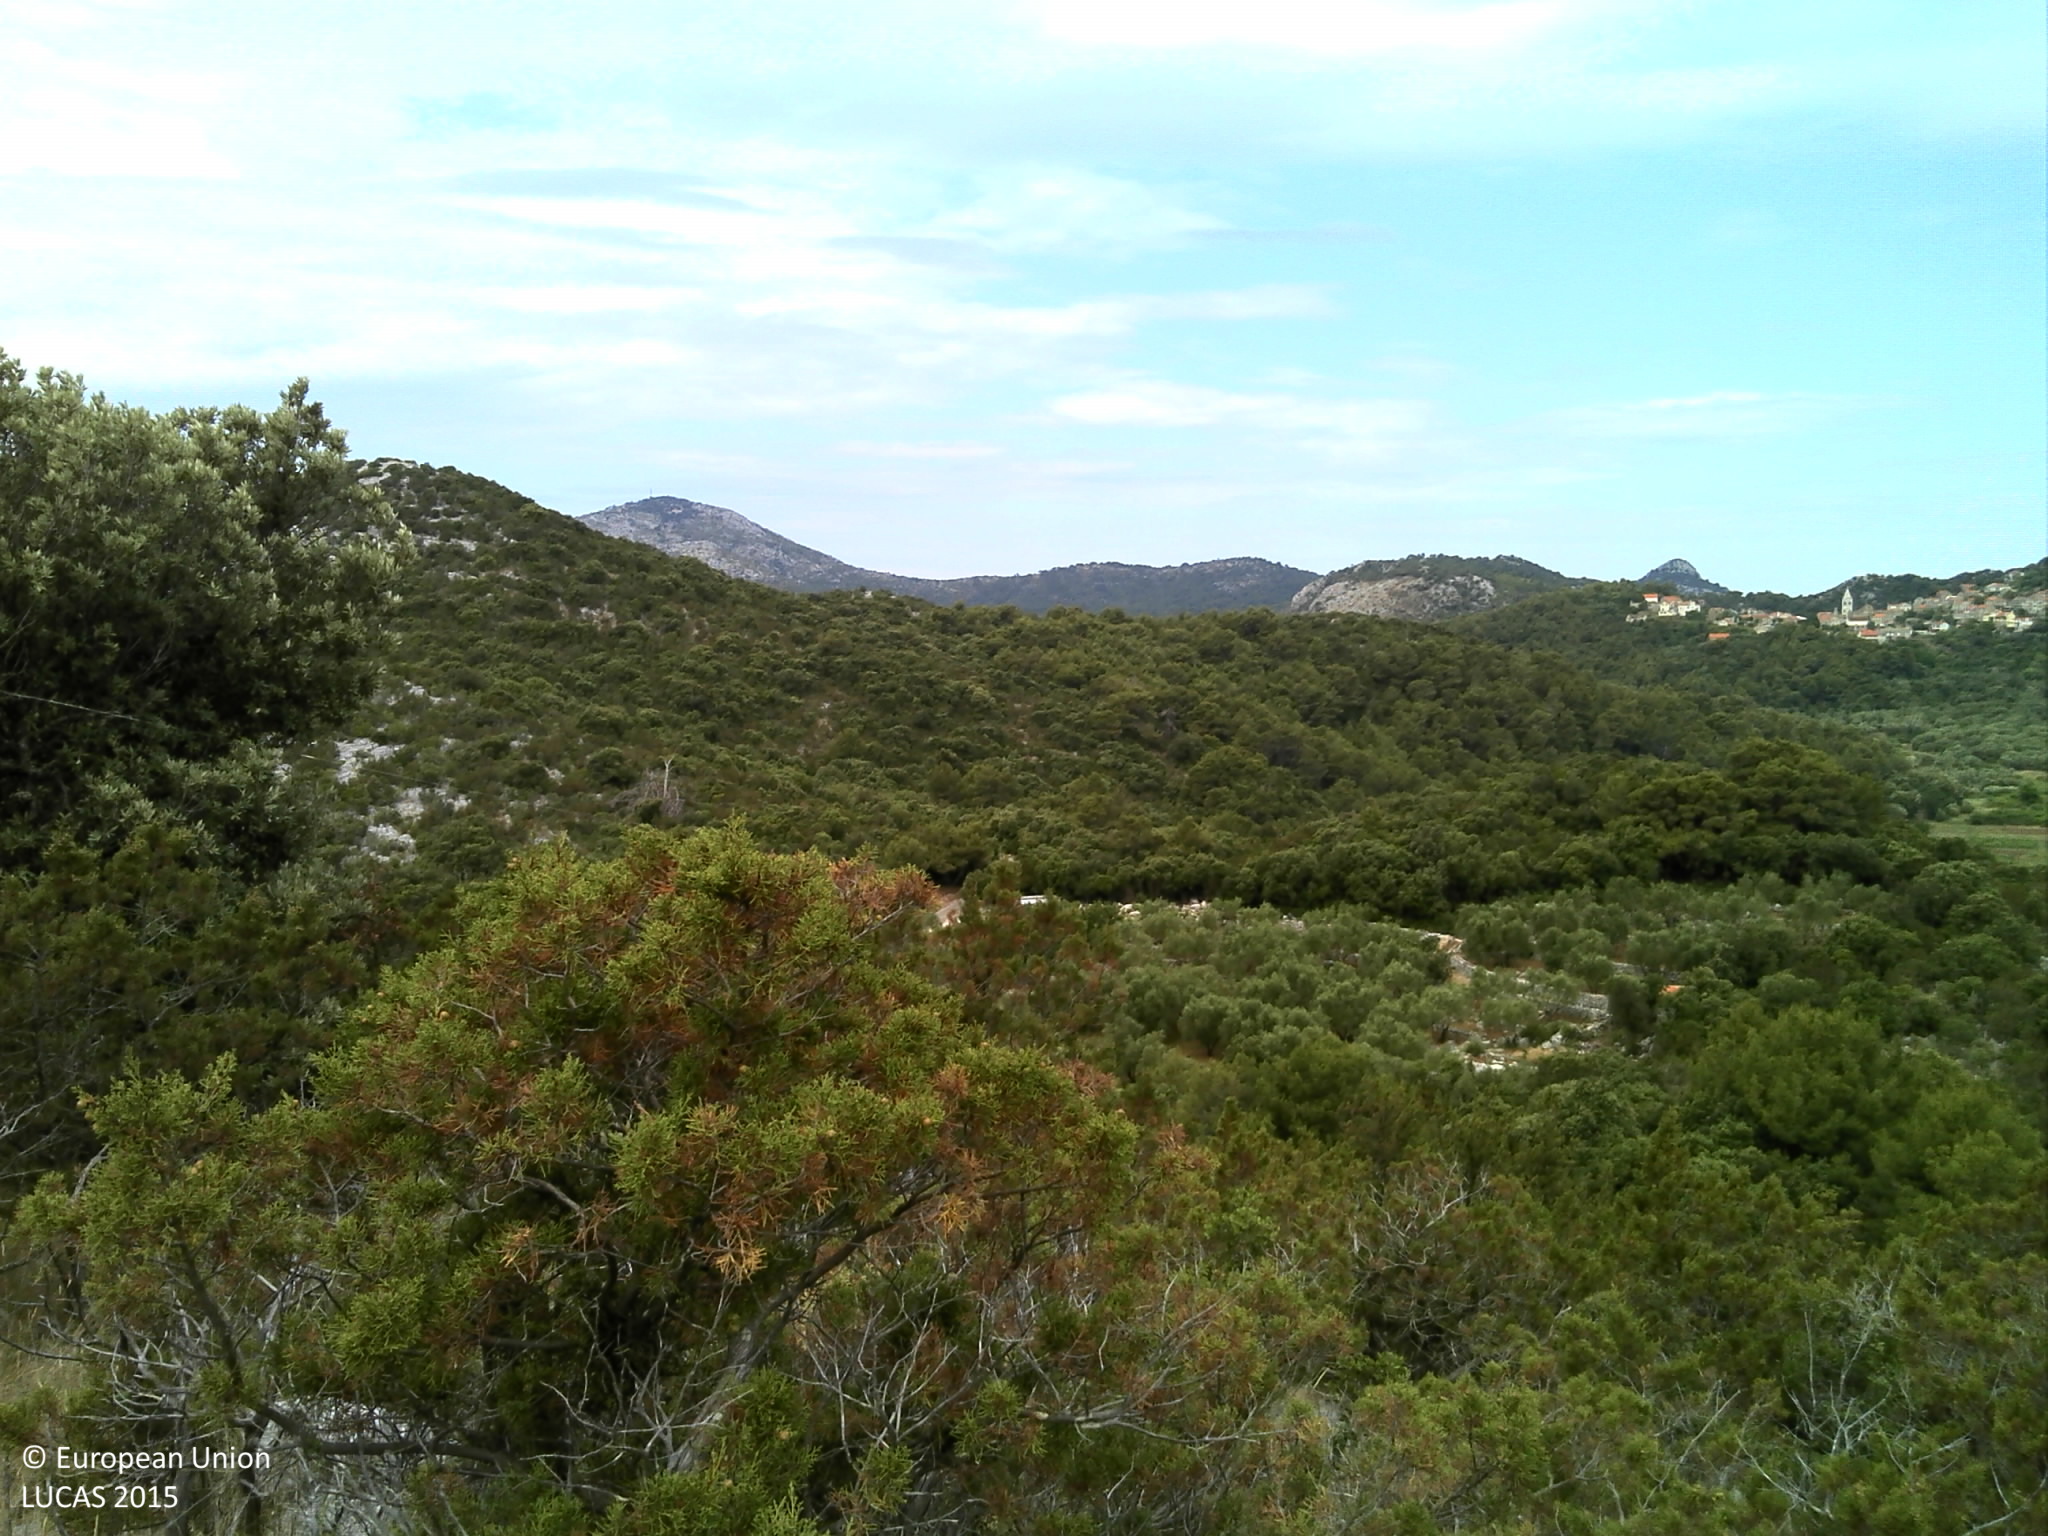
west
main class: Shrubland
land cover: Shrubland with sparse tree cover
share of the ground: > 75 %
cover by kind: shrubs 70 %, herbaceous plants 10 %, unconsolidated bare surface 10 %, coniferous forest trees 5 %, lichens and mosses 5 %
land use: Semi-natural and natural areas not in use
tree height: < 5 m
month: June
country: HR
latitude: 42.7617
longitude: 16.9166
